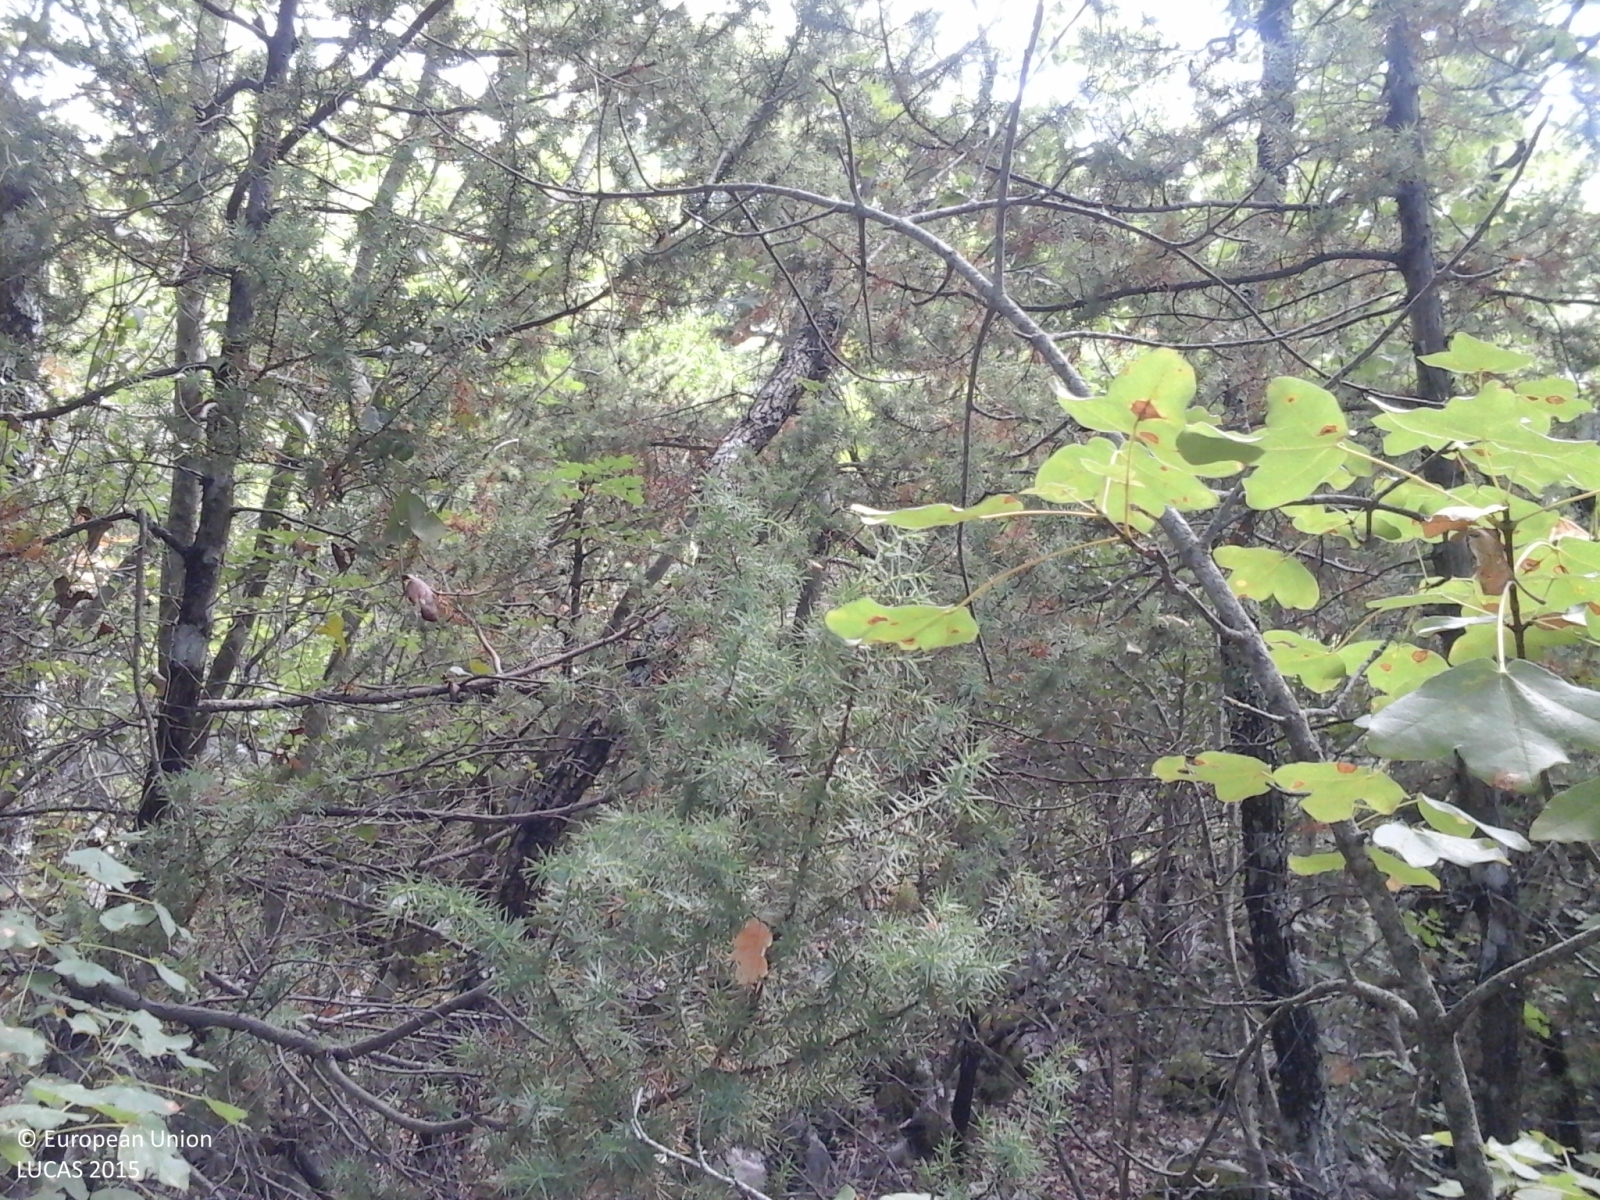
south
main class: Woodland
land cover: Broadleaved woodland
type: thermophilous deciduous forest
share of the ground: > 75 %
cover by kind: broadleaved forest trees 90 %, shrubs 10 %
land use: Forestry
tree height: < 5 m
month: August
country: IT
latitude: 42.6630
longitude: 12.3471
